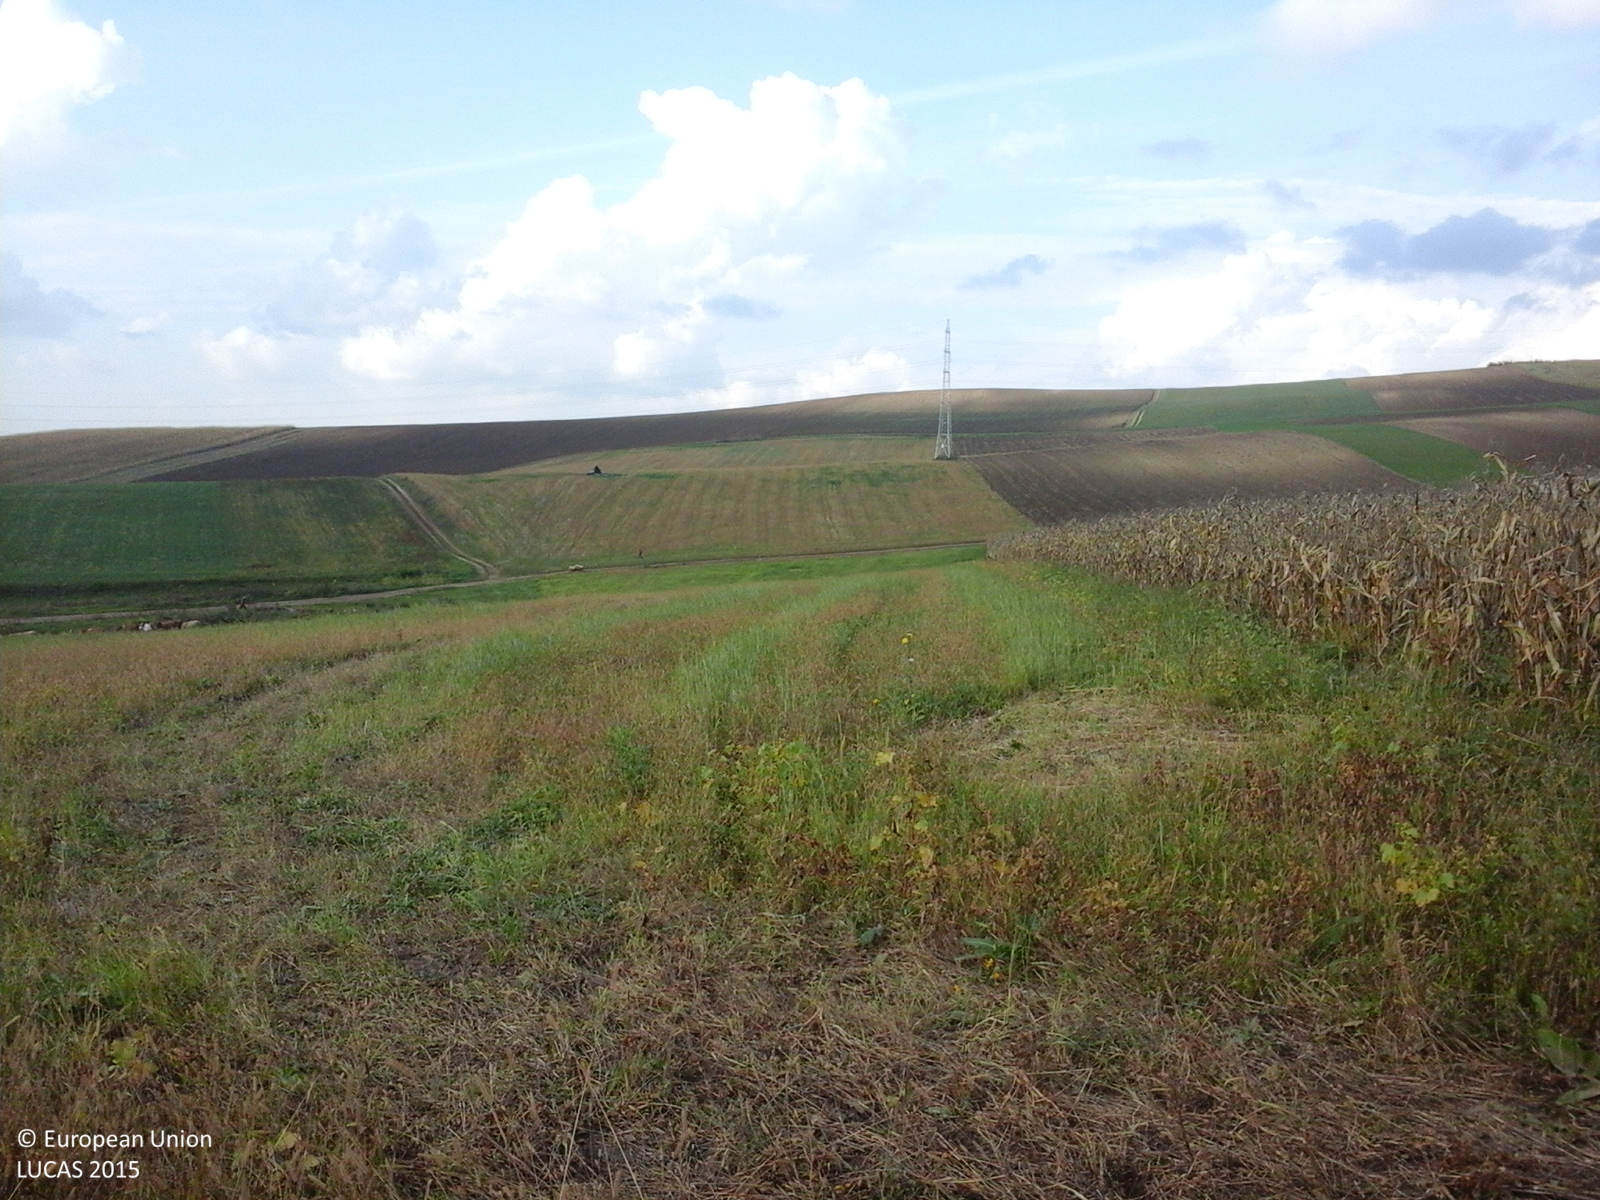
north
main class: Cropland
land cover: Maize
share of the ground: > 75 %
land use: Agriculture (excluding fallow land and kitchen gardens)
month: October
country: RO
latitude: 46.4883
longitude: 24.1095
